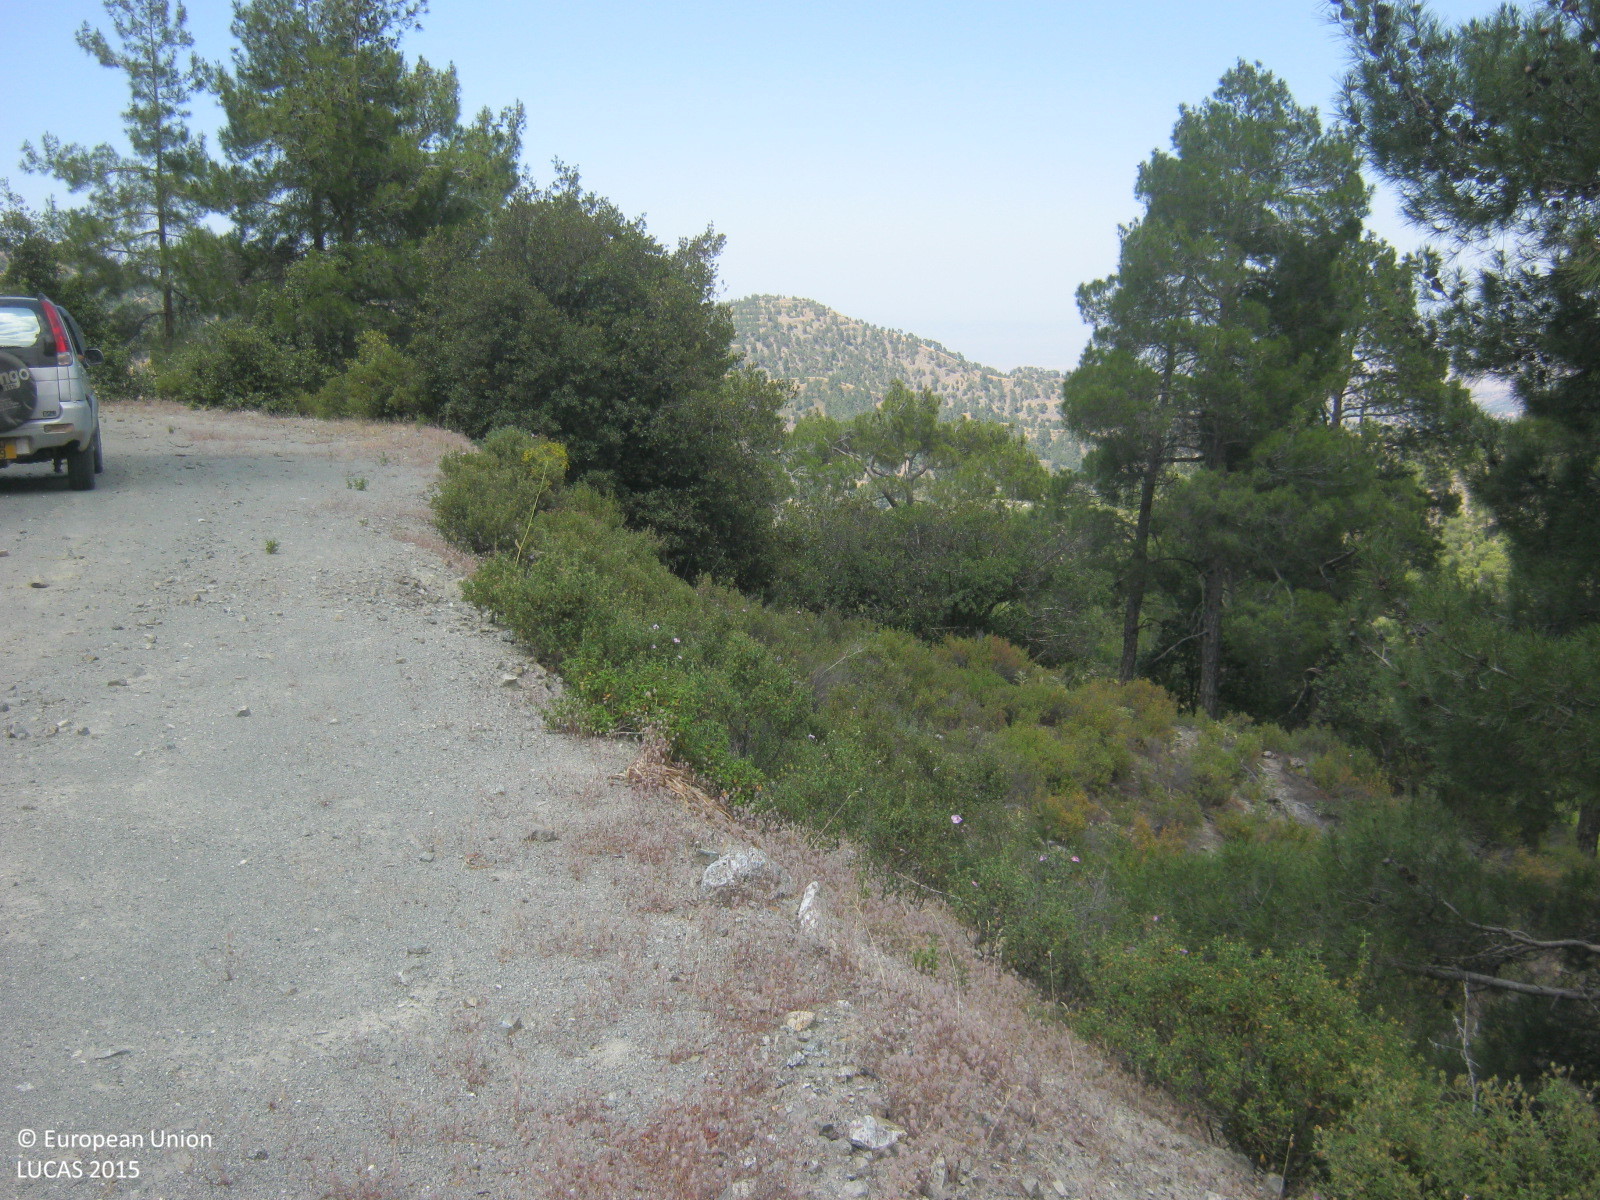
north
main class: Woodland
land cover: Pine dominated coniferous woodland
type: coniferous forest of the mediterranean region
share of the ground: > 75 %
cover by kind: coniferous forest trees 80 %, shrubs 10 %, broadleaved forest trees 5 %, unconsolidated bare surface 5 %
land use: Forestry
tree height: > 5 m
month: June
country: CY
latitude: 34.9985
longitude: 32.8594
